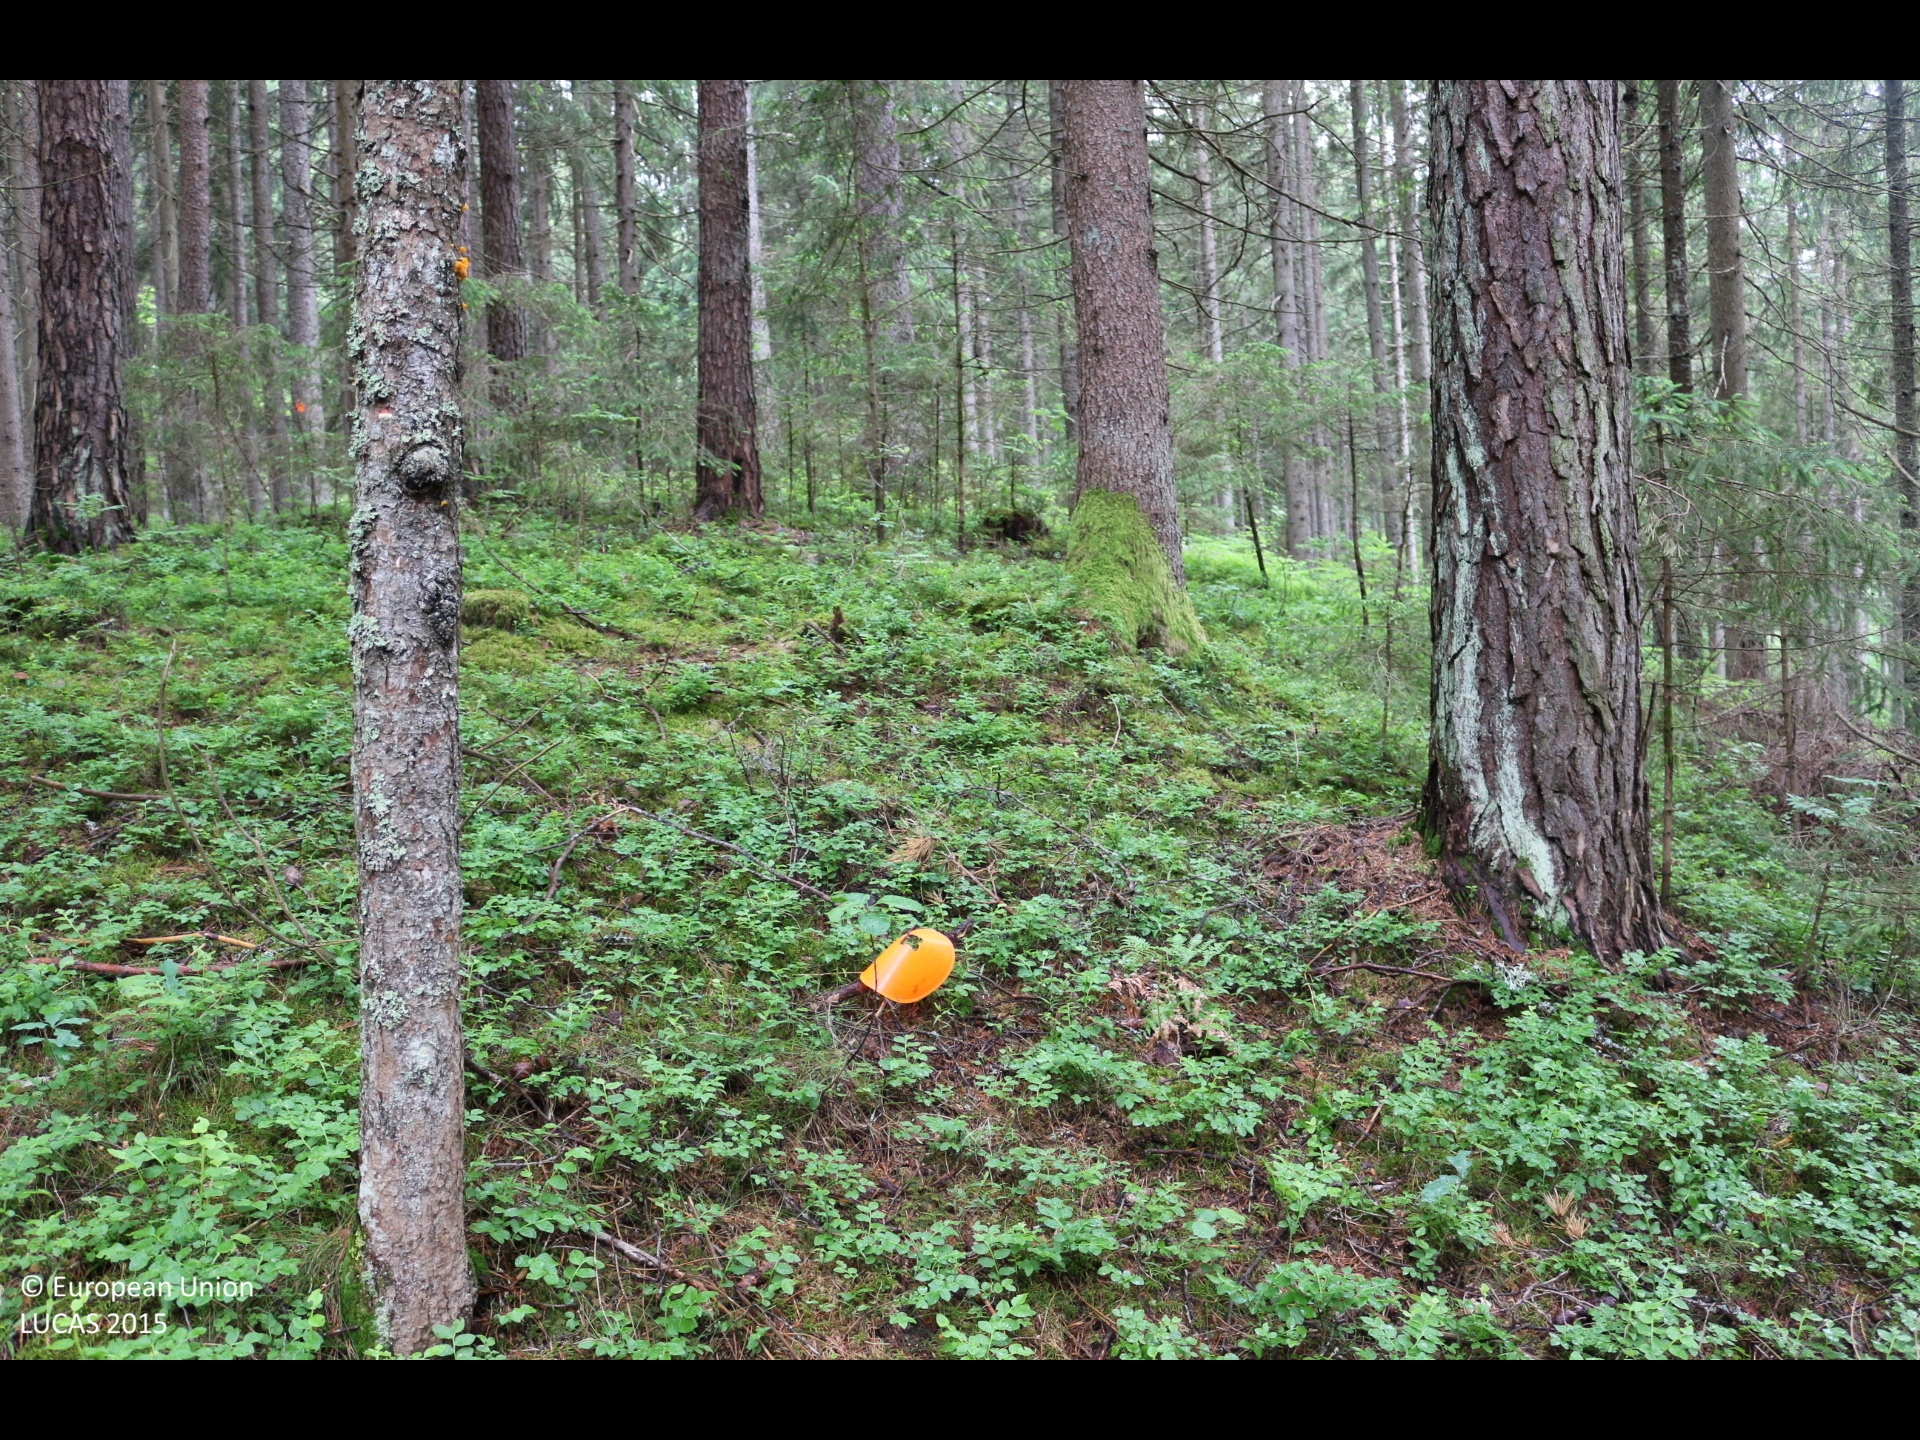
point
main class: Woodland
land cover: Spruce dominated coniferous woodland
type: alpine coniferous forest
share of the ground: > 75 %
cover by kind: coniferous forest trees 95 %, broadleaved forest trees 5 %
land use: Forestry
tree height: > 5 m
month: May
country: AT
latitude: 46.6868
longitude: 14.1161
